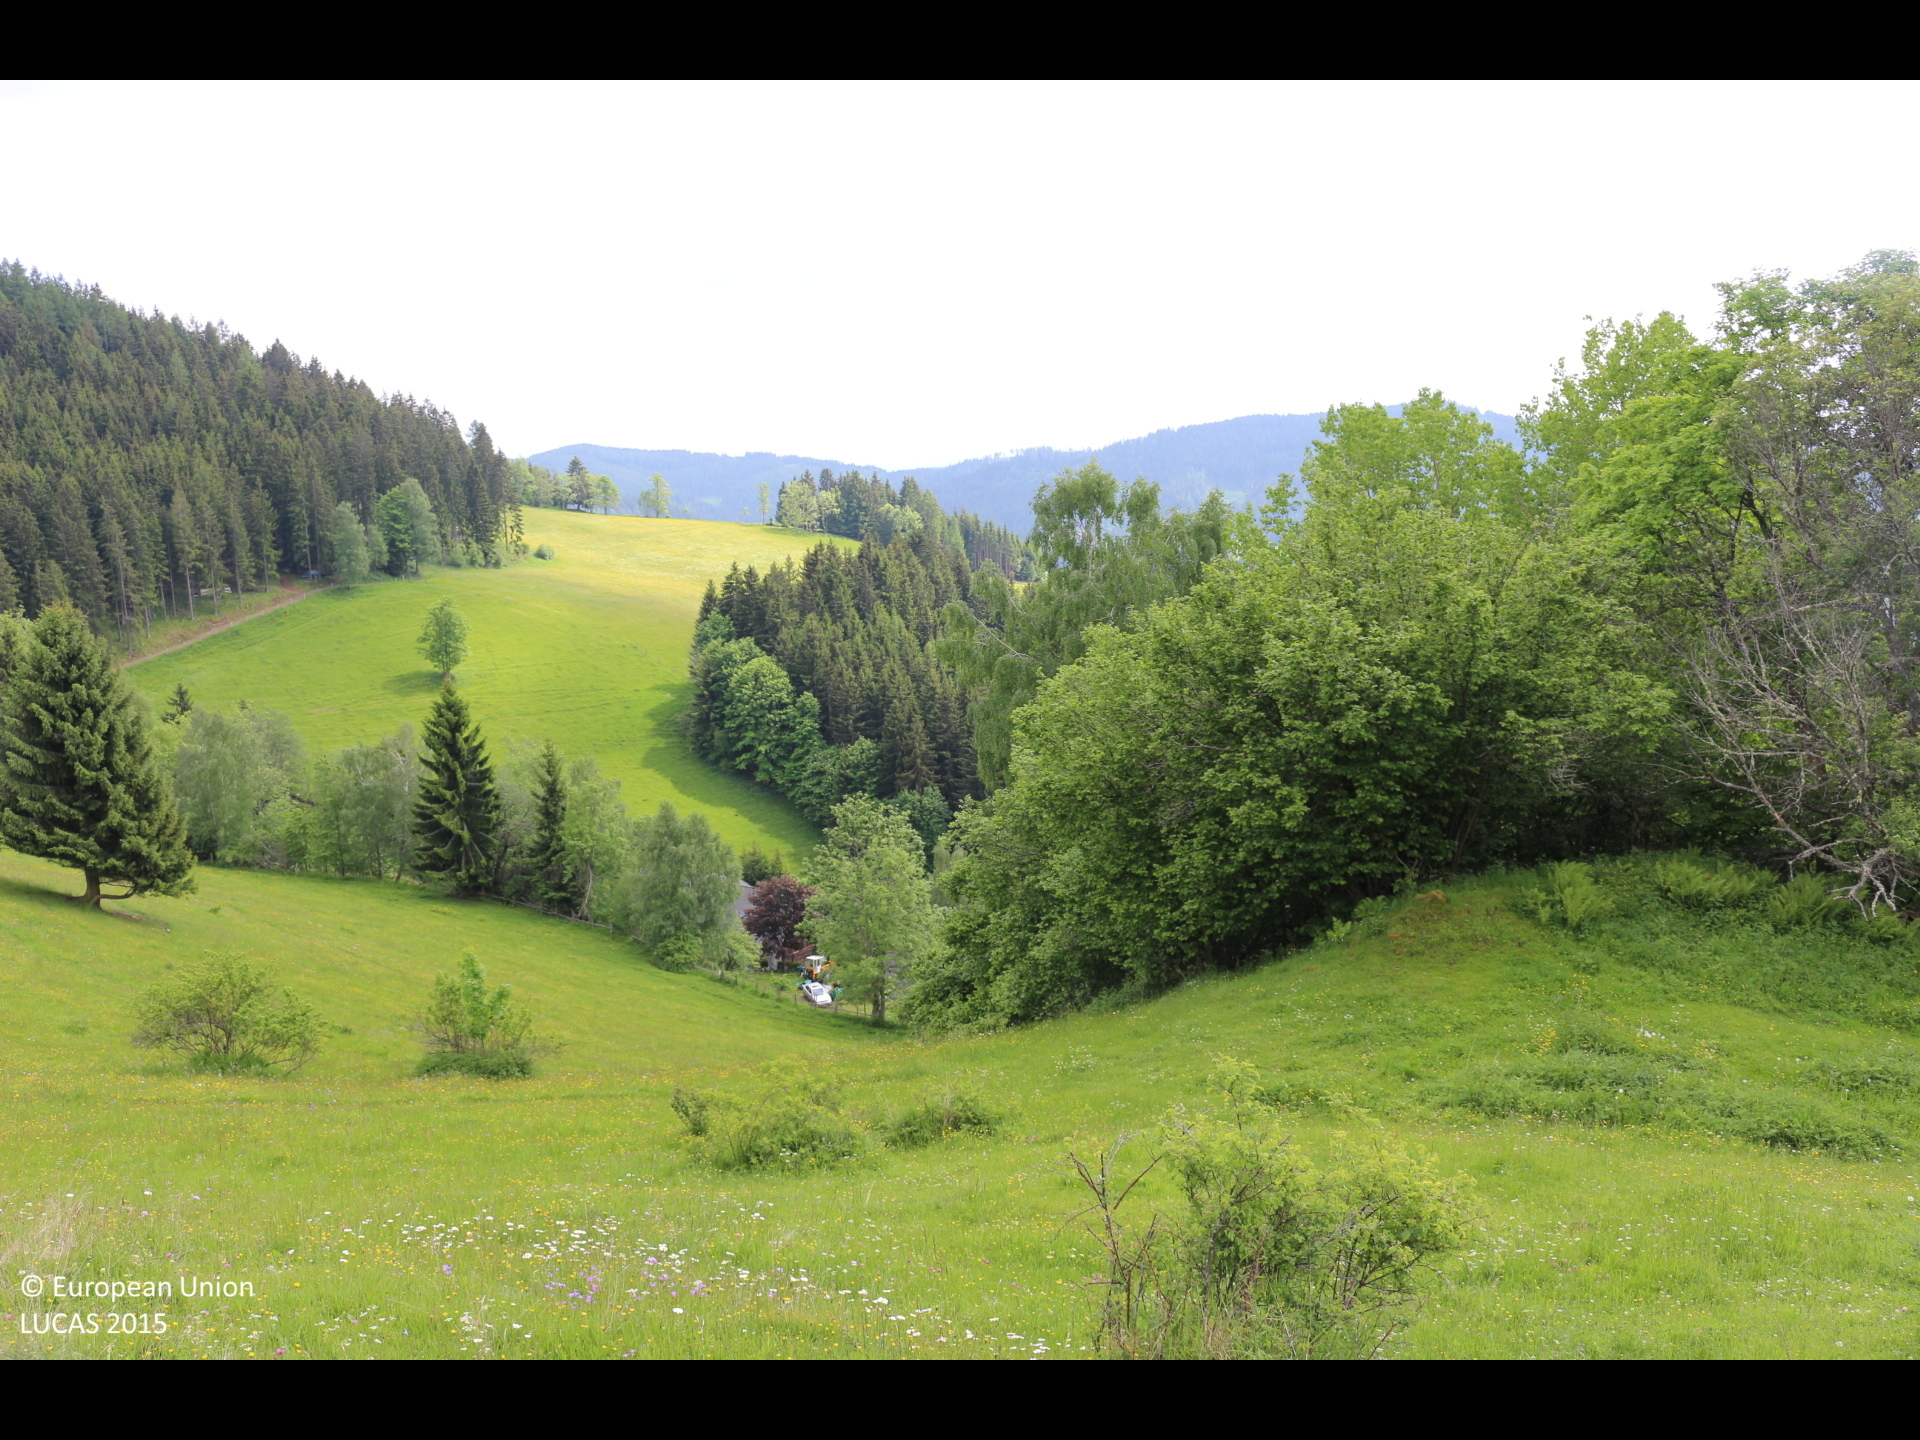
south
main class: Grassland
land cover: Grassland without tree/shrub cover
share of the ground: > 75 %
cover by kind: herbaceous plants 100 %
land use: Agriculture (excluding fallow land and kitchen gardens)
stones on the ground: < 10 %
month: June
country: AT
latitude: 46.7936
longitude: 14.5964
